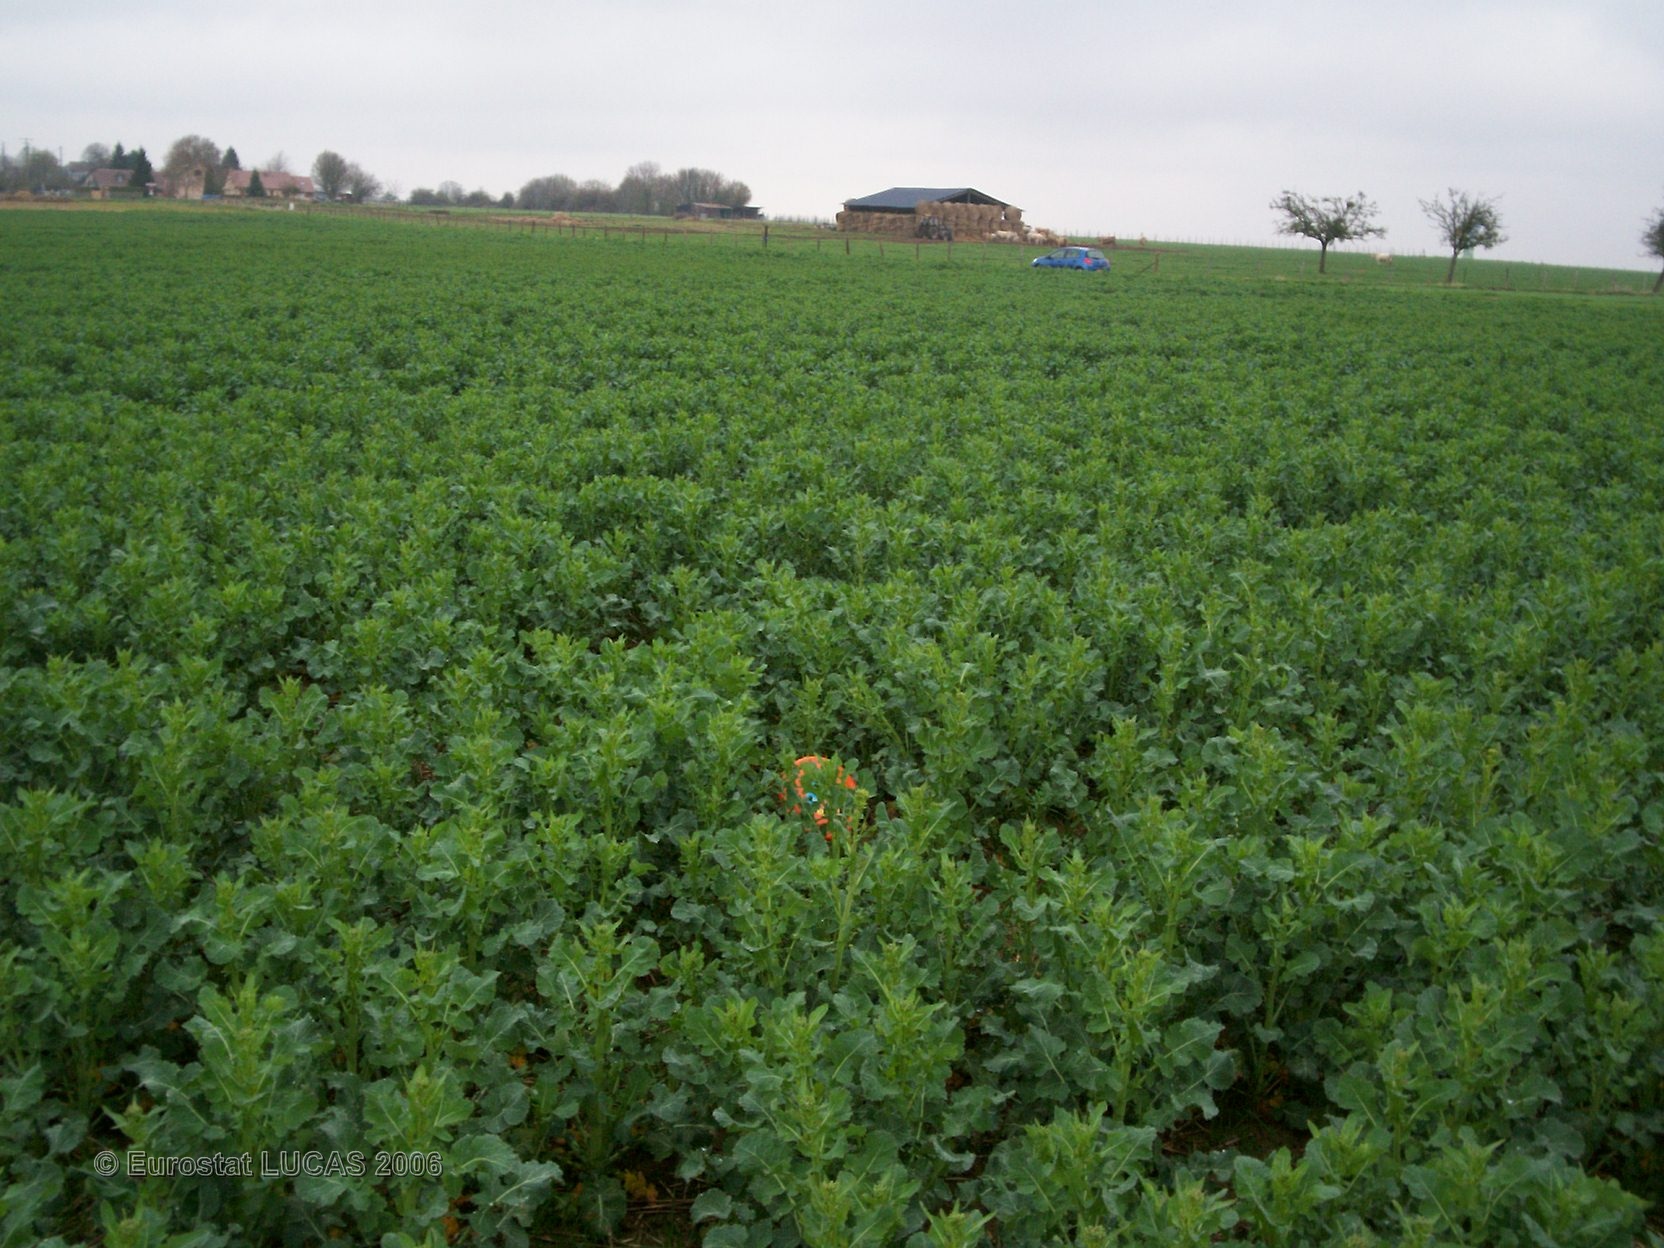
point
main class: Cropland
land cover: Rape and turnip rape
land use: Agriculture (excluding fallow land and kitchen gardens)
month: April
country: FR
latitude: 49.2135
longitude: 1.0139
